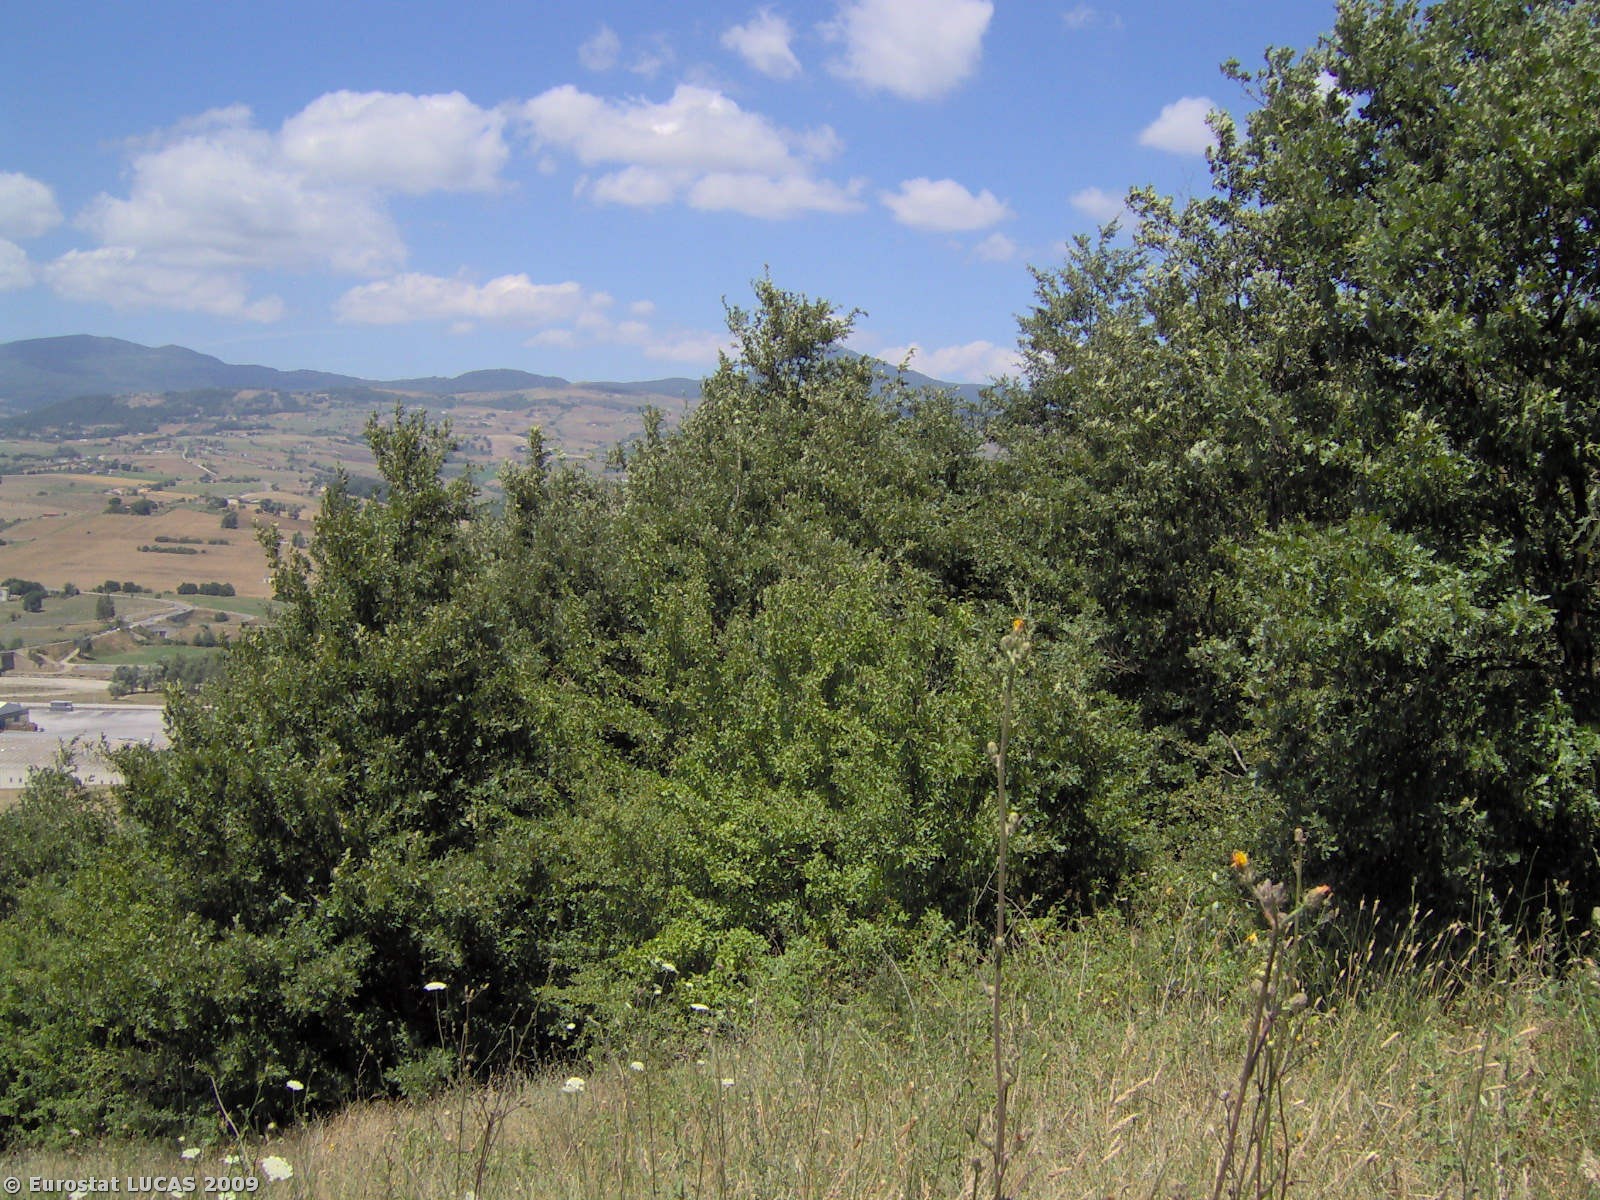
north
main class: Grassland
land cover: Spontaneously vegetated surfaces
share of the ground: > 75 %
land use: Fallow land
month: July
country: IT
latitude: 40.6904
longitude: 15.5518
